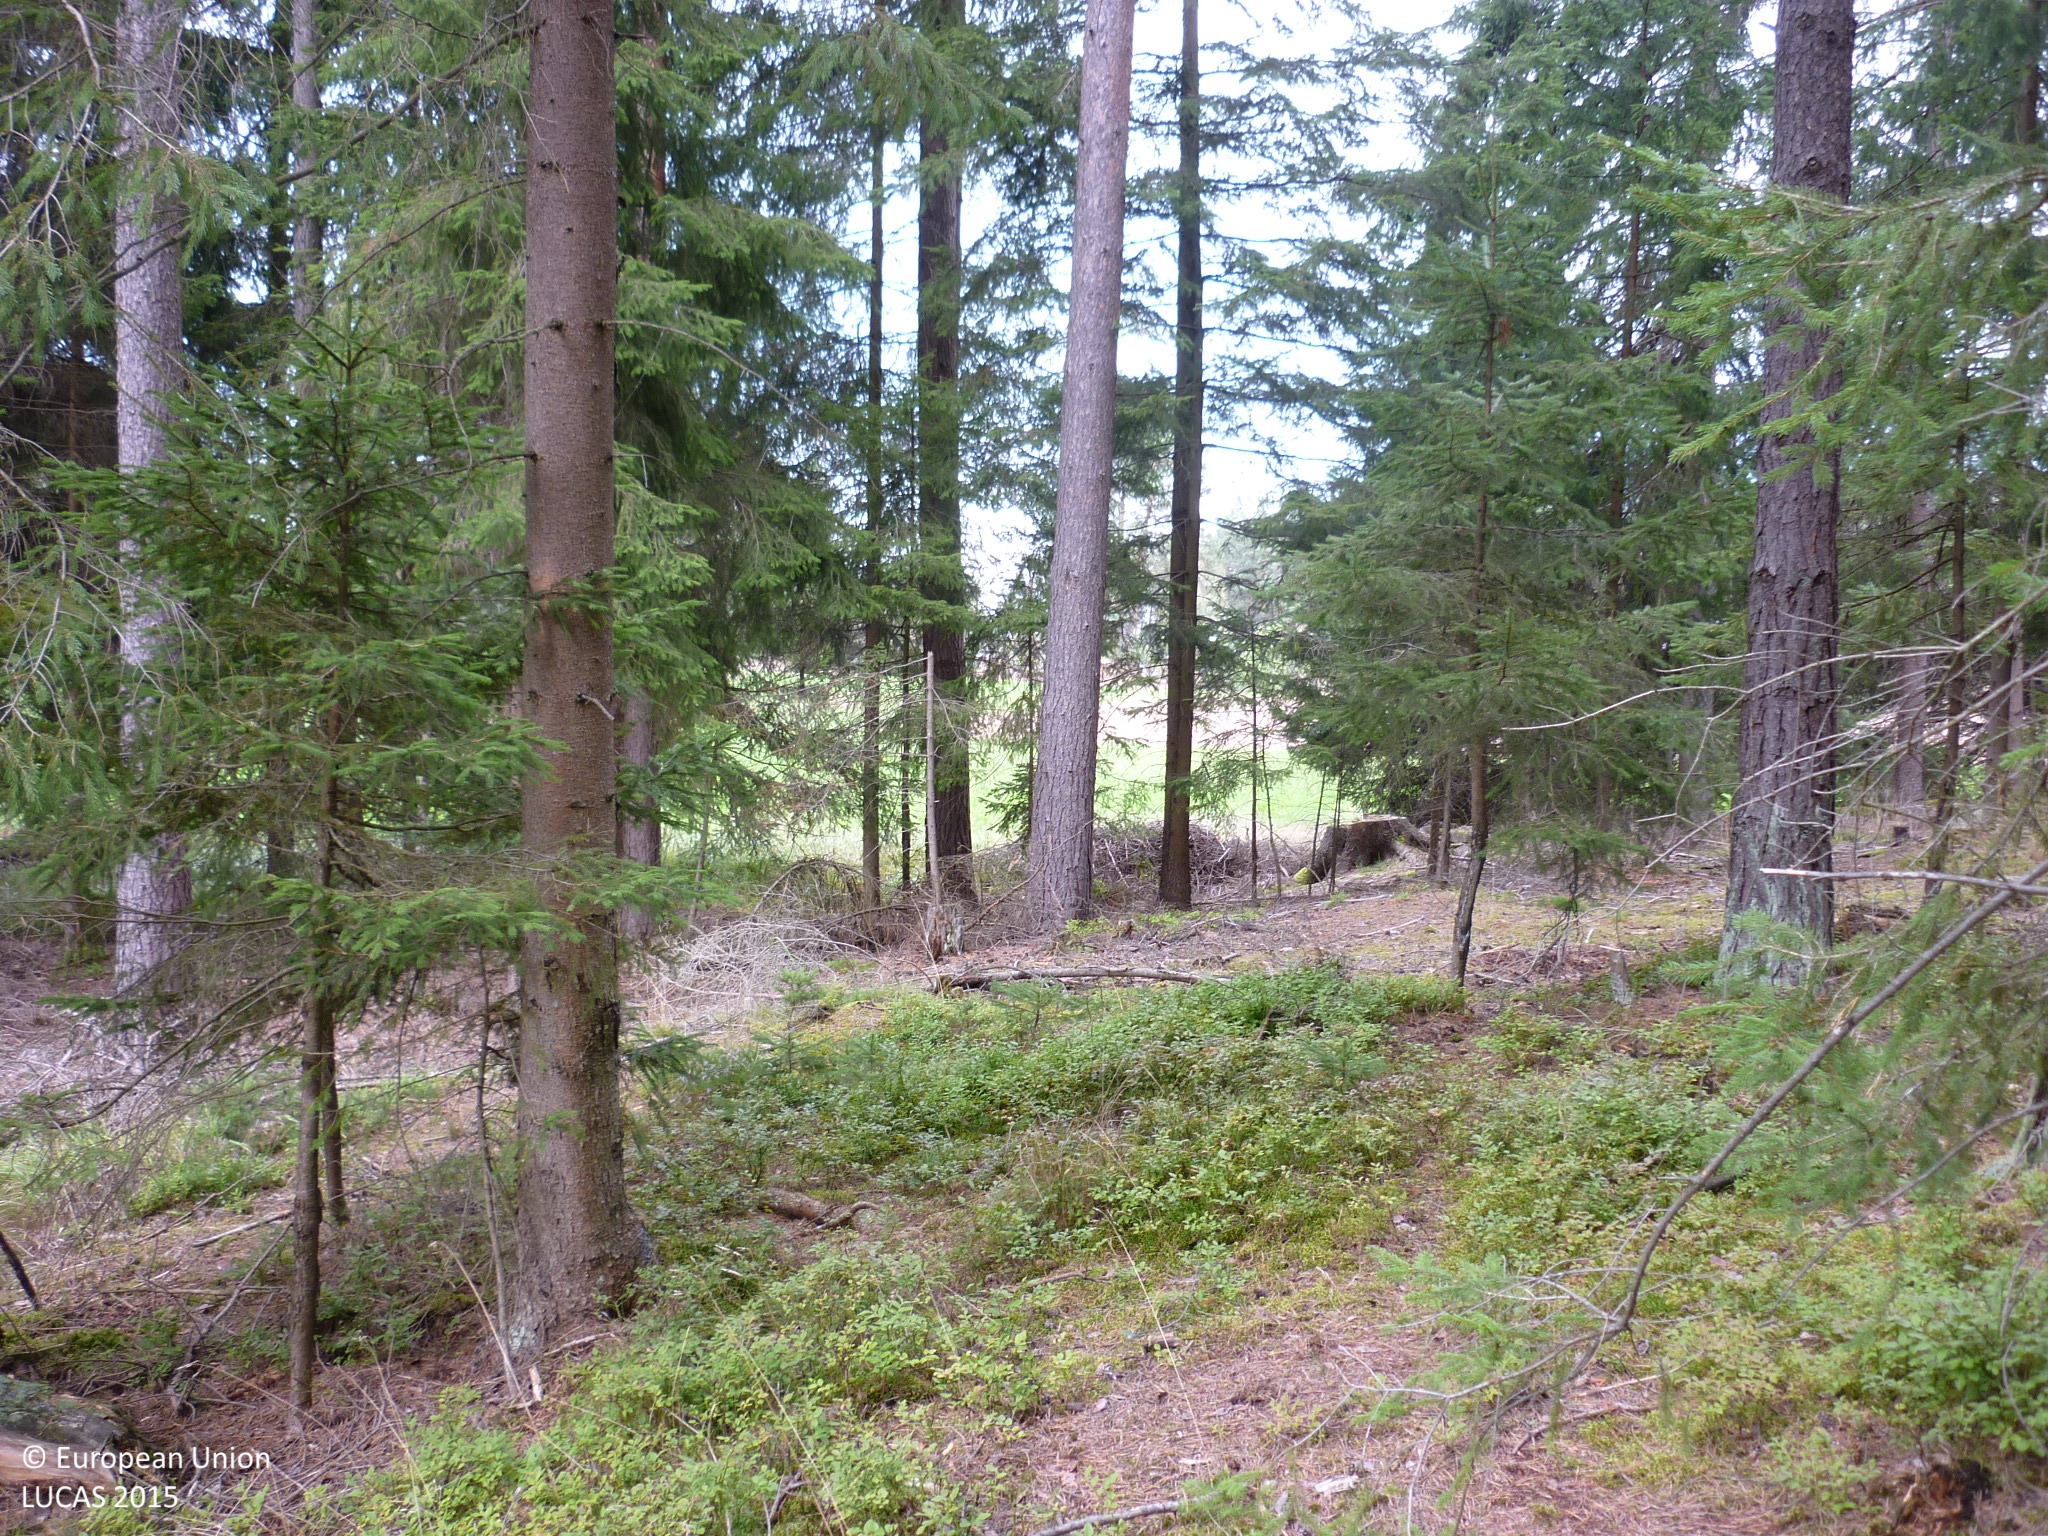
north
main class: Woodland
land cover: Spruce dominated coniferous woodland
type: hemiboreal forest and nemoral coniferous forest and mixed broadleaved-coniferous forest
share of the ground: > 75 %
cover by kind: coniferous forest trees 100 %
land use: Forestry
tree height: > 5 m
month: September
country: AT
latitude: 48.8479
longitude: 15.0305
